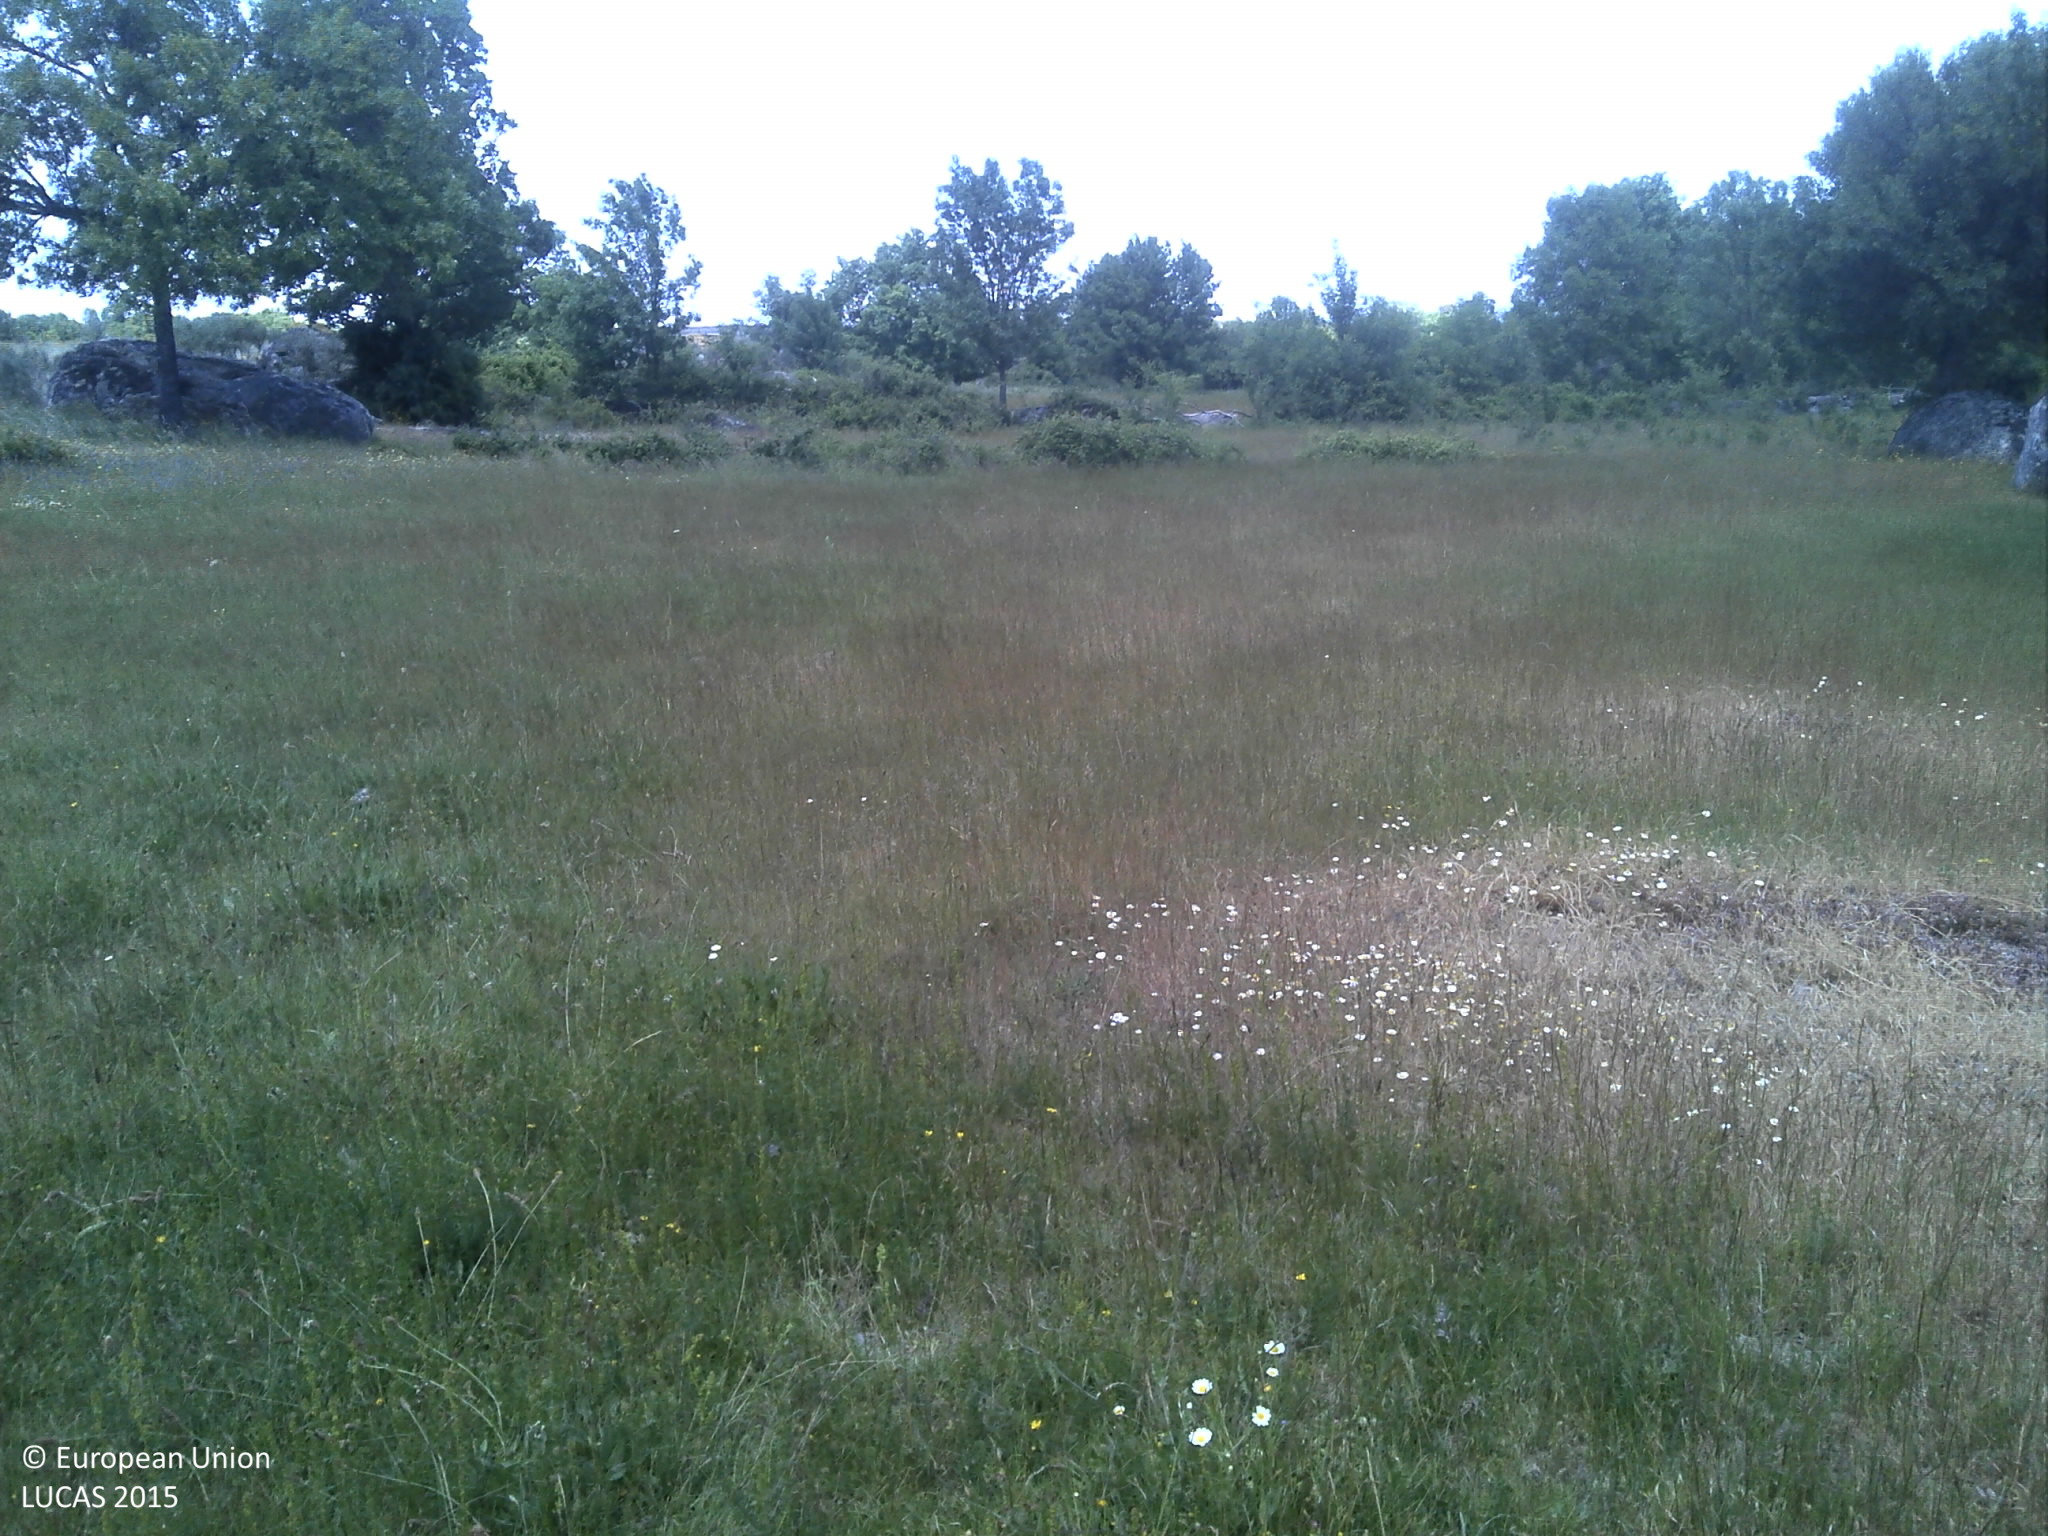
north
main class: Grassland
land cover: Grassland with sparse tree/shrub cover
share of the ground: 50 - 75 %
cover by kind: herbaceous plants 70 %, consolidated bare surface 10 %, broadleaved forest trees 5 %, shrubs 5 %
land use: Agriculture (excluding fallow land and kitchen gardens)
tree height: > 5 m
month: May
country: PT
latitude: 40.7016
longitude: -7.1363
